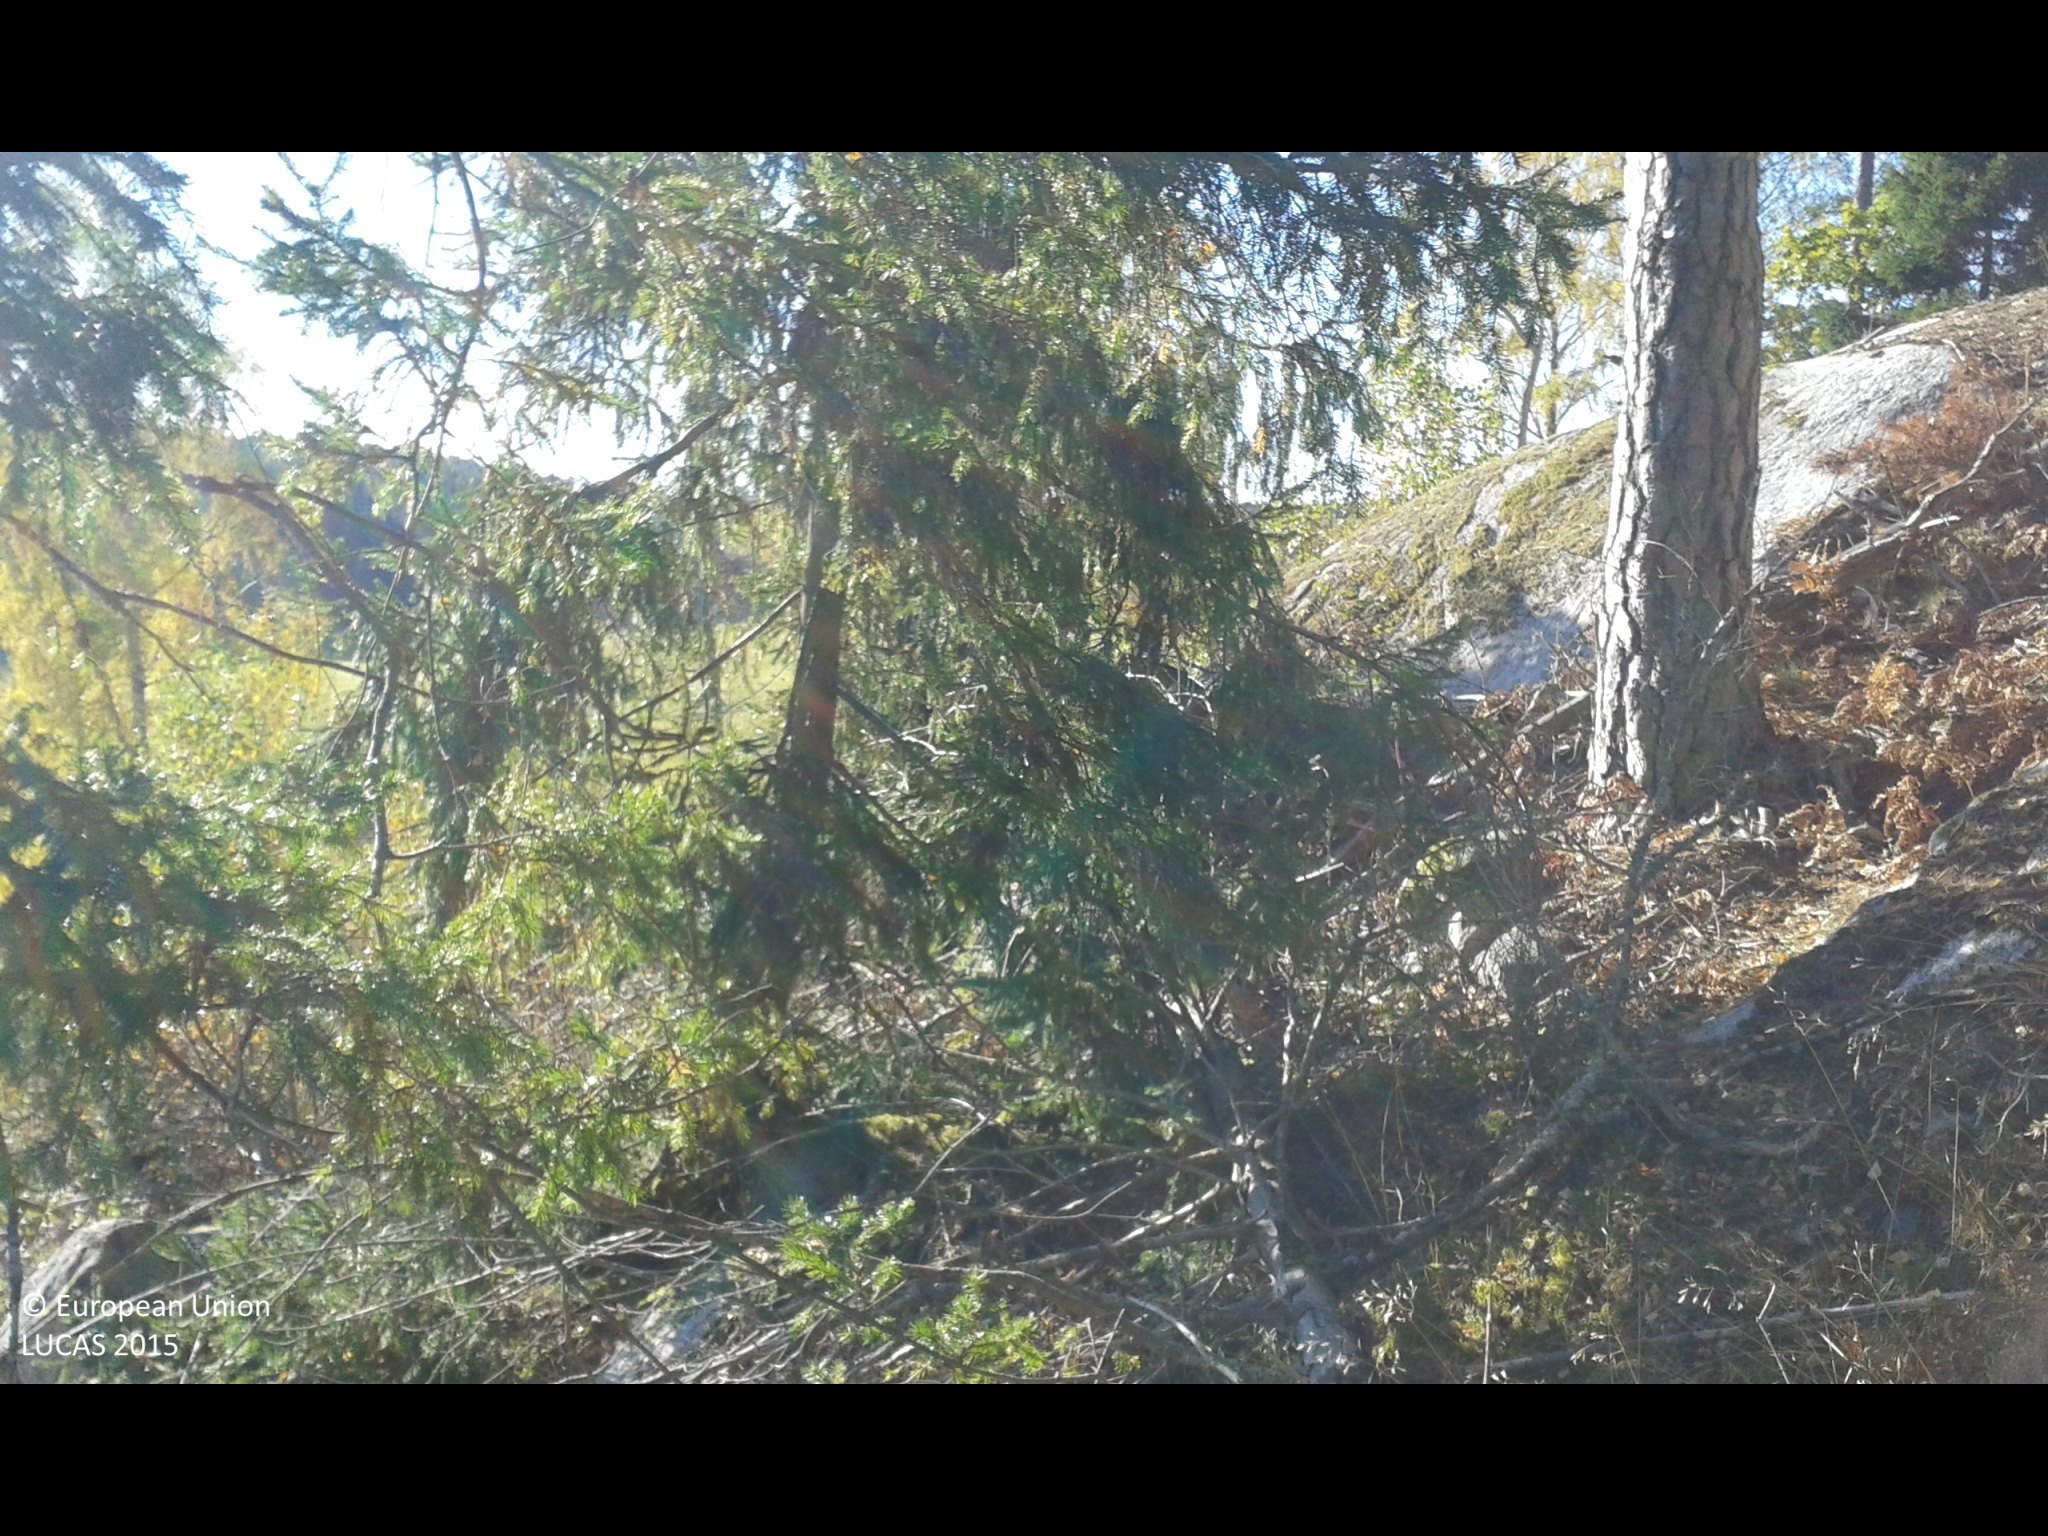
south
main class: Woodland
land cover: Spruce dominated mixed woodland
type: boreal forest
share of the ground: 25 - 50 %
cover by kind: herbaceous plants 55 %, coniferous forest trees 25 %, broadleaved forest trees 20 %
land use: Forestry
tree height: > 5 m
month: October
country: SE
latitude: 58.8329
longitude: 17.3254
